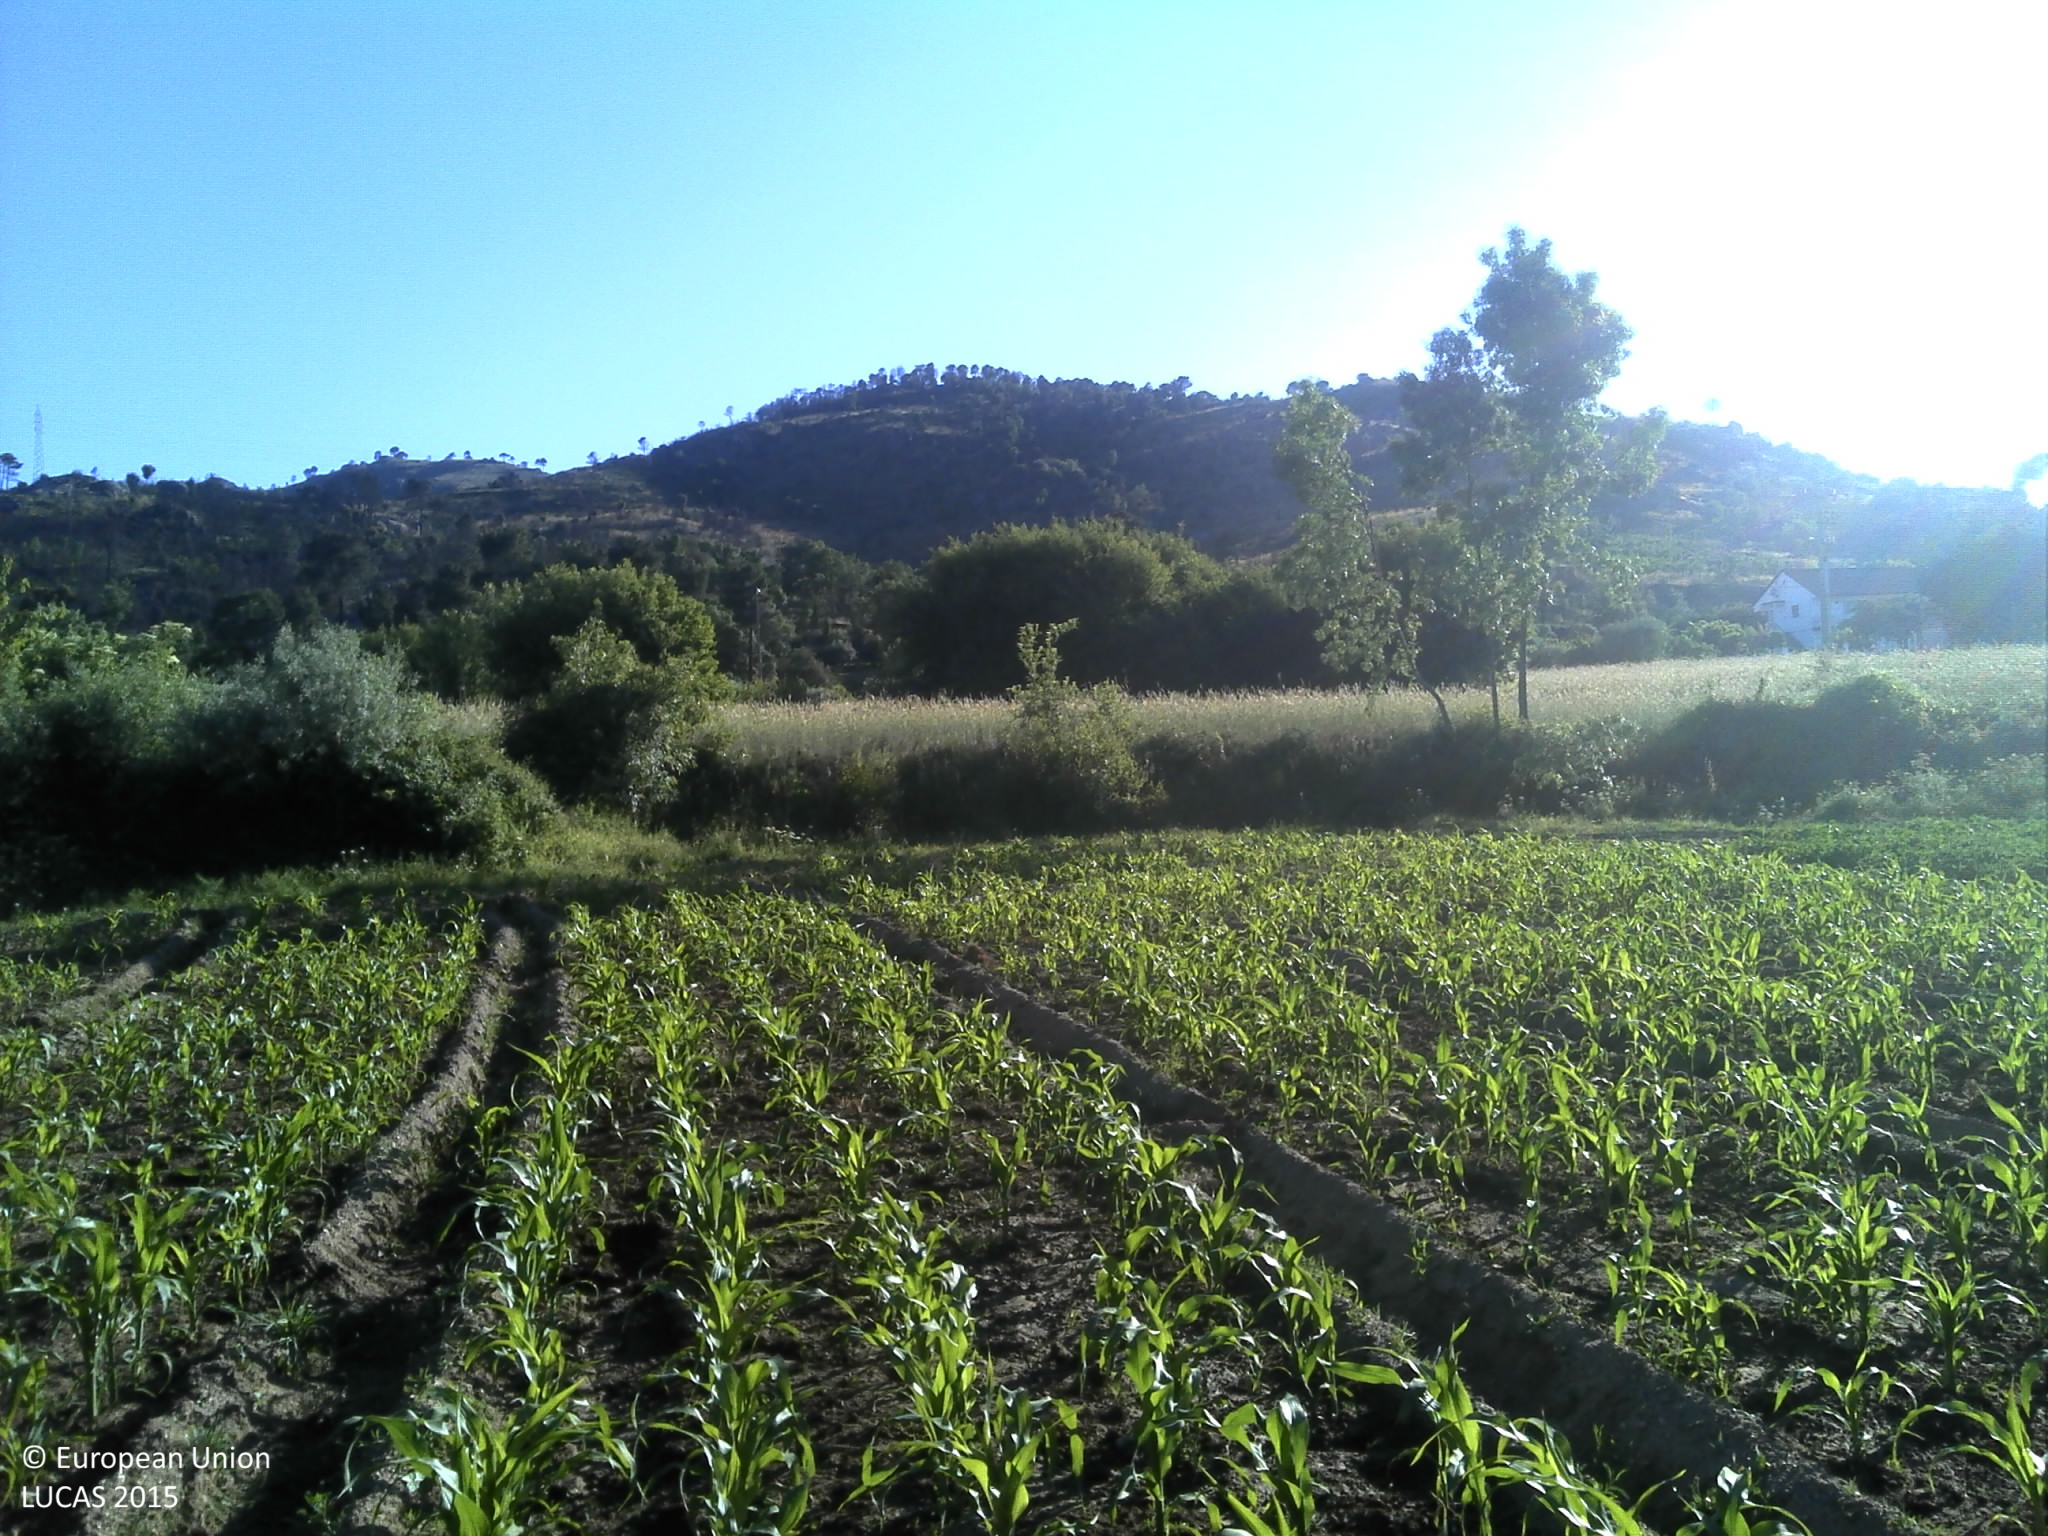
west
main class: Cropland
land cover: Maize
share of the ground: 10 - 25 %
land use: Agriculture (excluding fallow land and kitchen gardens)
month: May
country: PT
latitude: 40.6162
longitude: -7.3065
